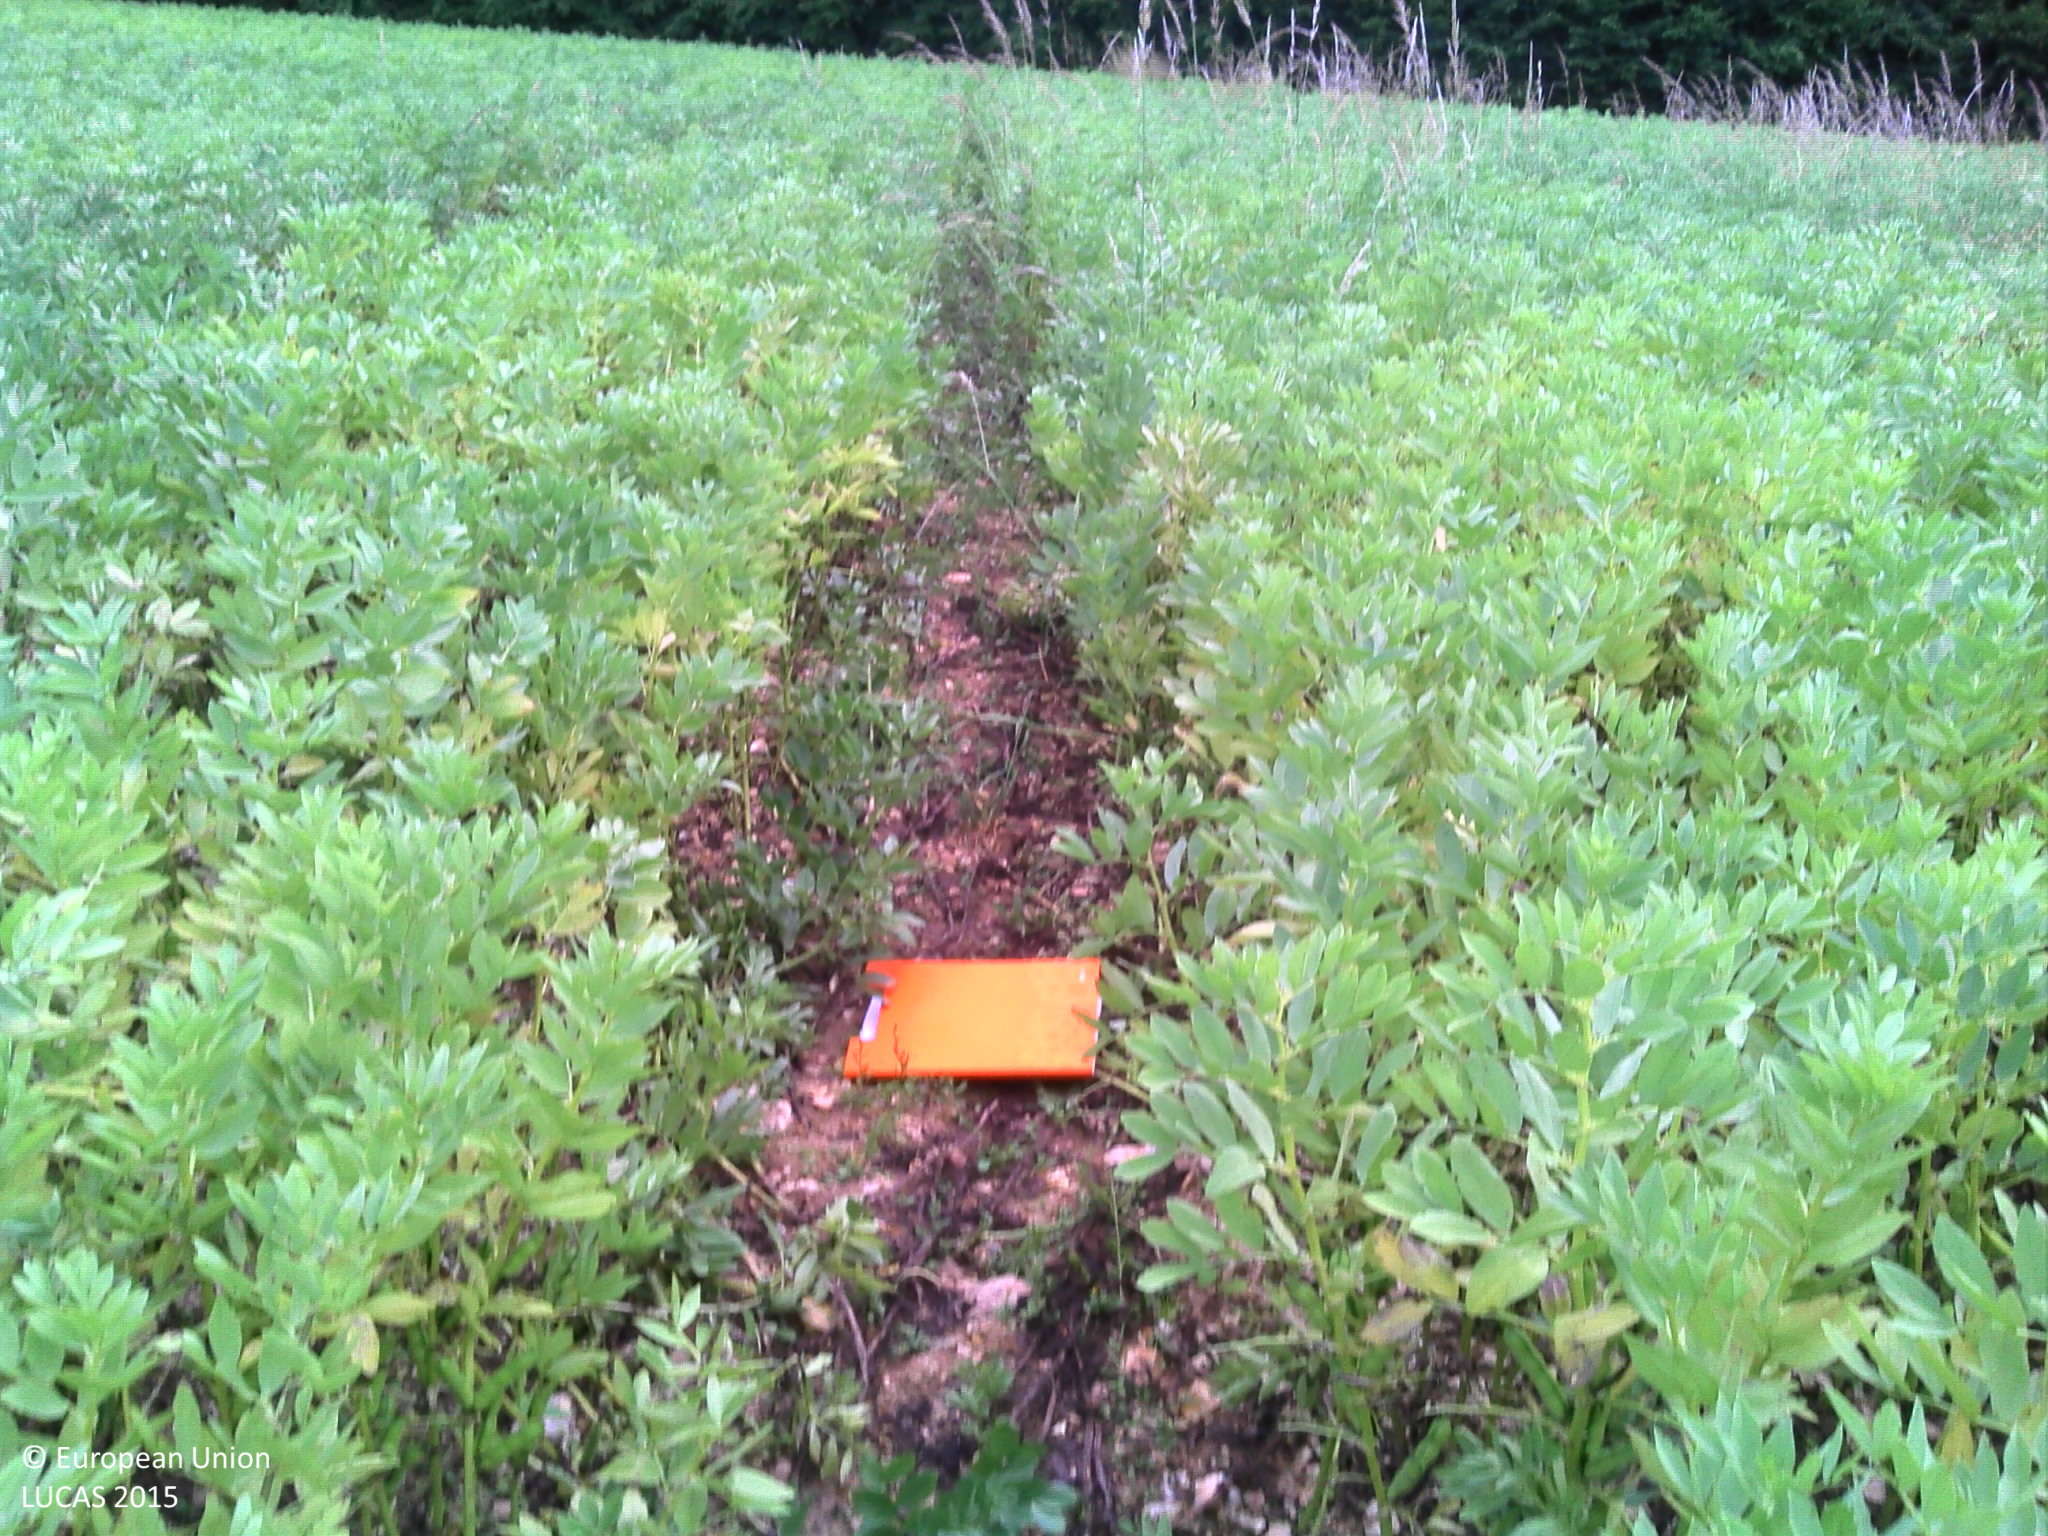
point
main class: Cropland
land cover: Dry pulses
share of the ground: > 75 %
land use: Agriculture (excluding fallow land and kitchen gardens)
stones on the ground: 10 - 25 %
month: June
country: FR
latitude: 47.3937
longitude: 2.5601
